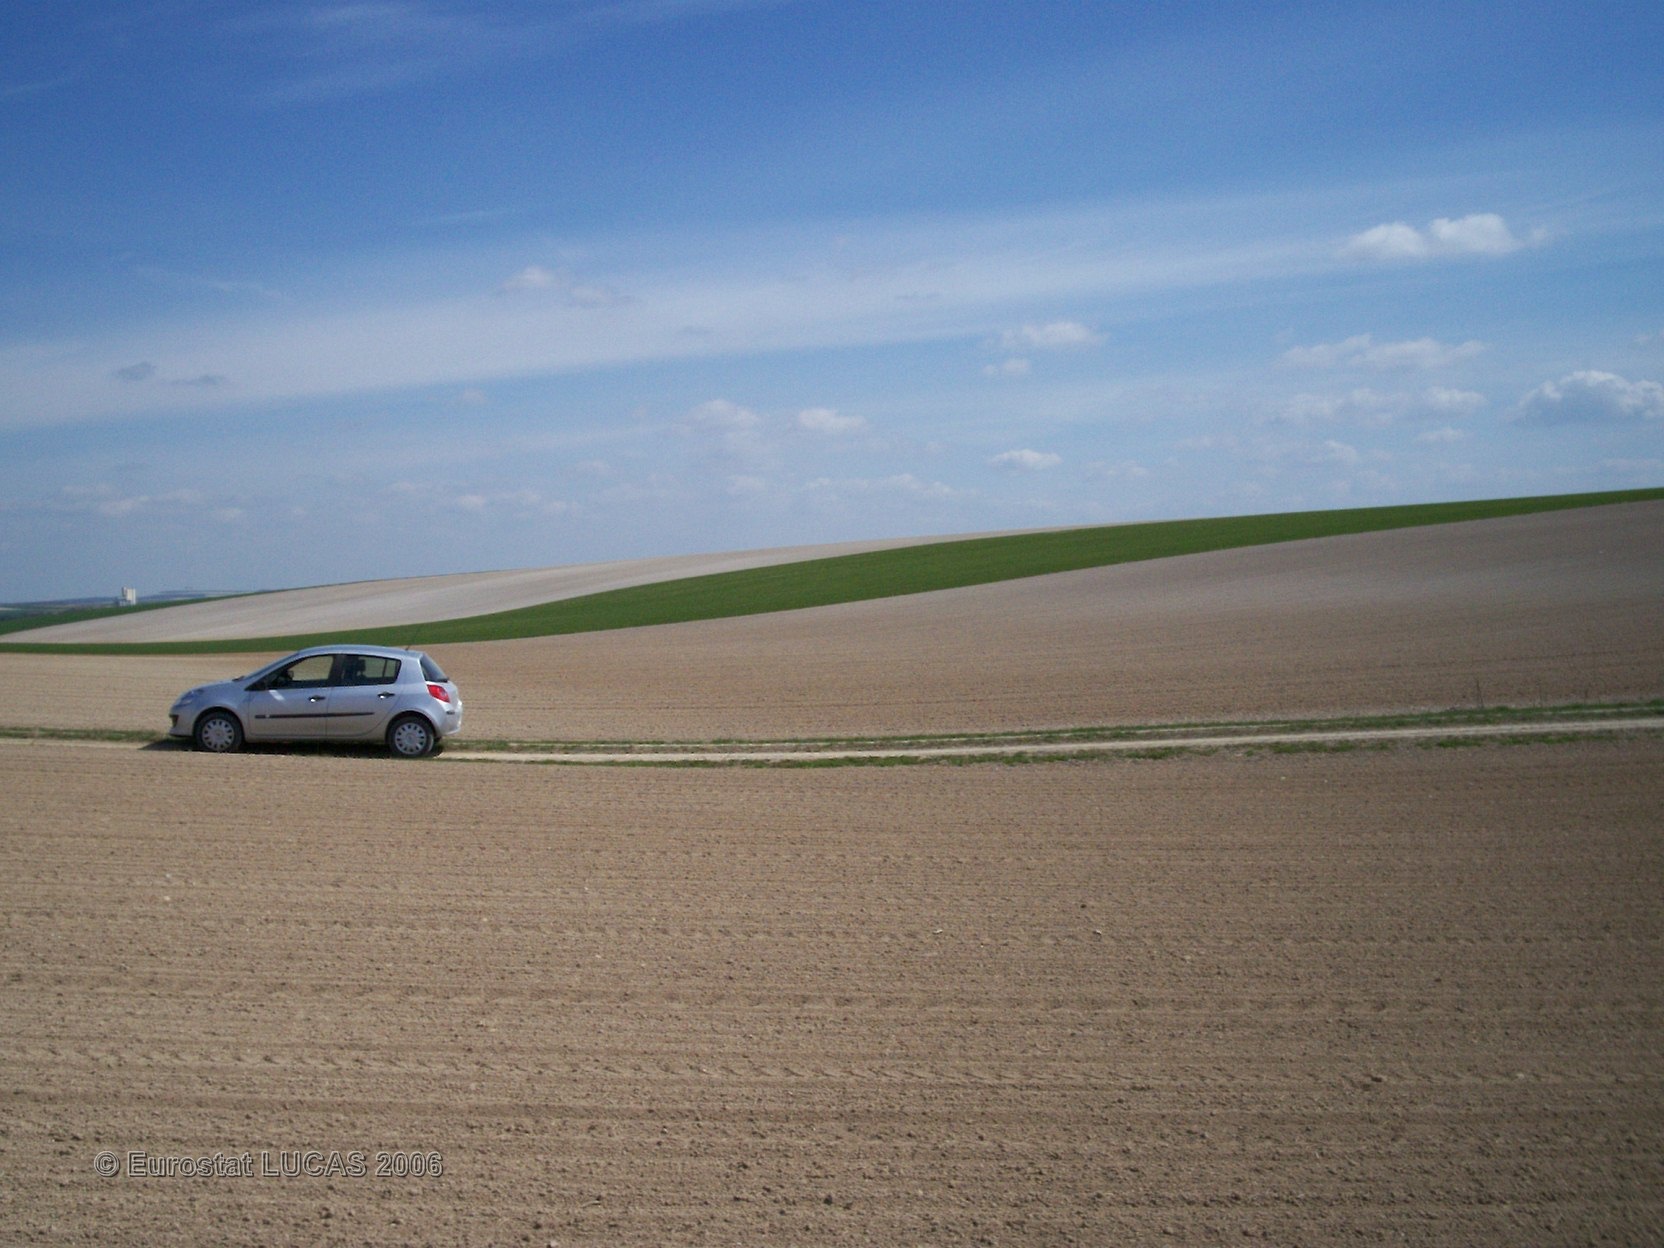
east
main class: Cropland
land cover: Sugar beet
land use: Agriculture (excluding fallow land and kitchen gardens)
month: June
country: FR
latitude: 49.2343
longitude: 4.3791
